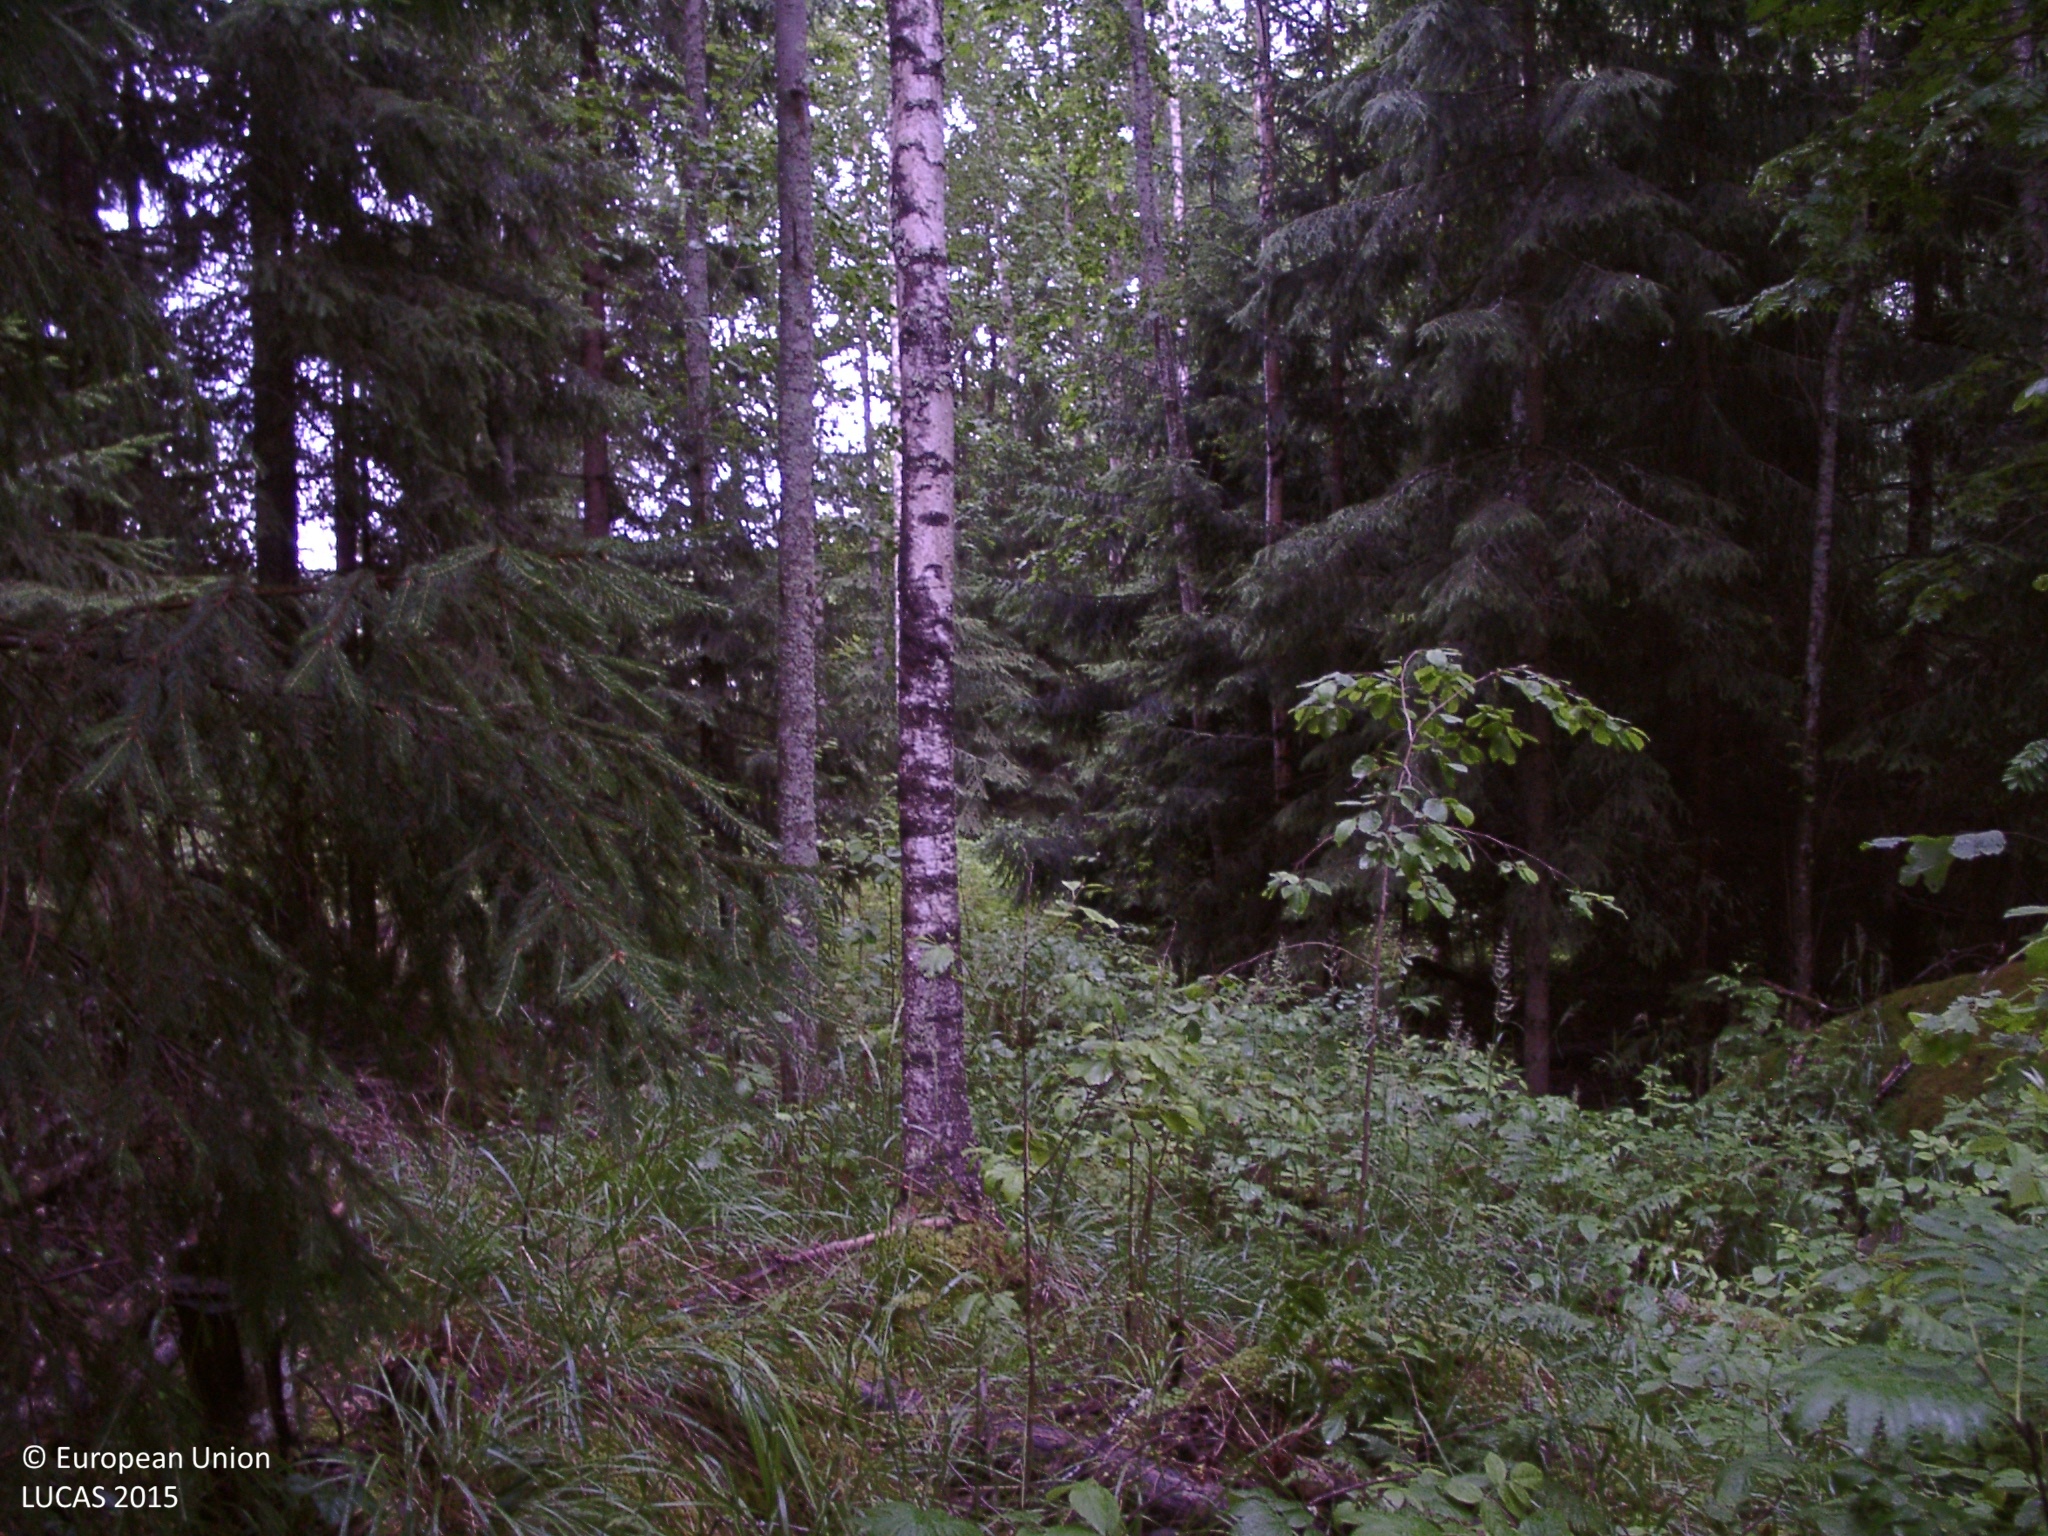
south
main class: Woodland
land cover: Spruce dominated mixed woodland
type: boreal forest
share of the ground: 50 - 75 %
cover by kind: coniferous forest trees 35 %, broadleaved forest trees 35 %, shrubs 15 %, herbaceous plants 10 %, lichens and mosses 5 %
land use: Forestry
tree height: > 5 m
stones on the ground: < 10 %
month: July
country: FI
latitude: 61.9557
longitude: 25.2691
